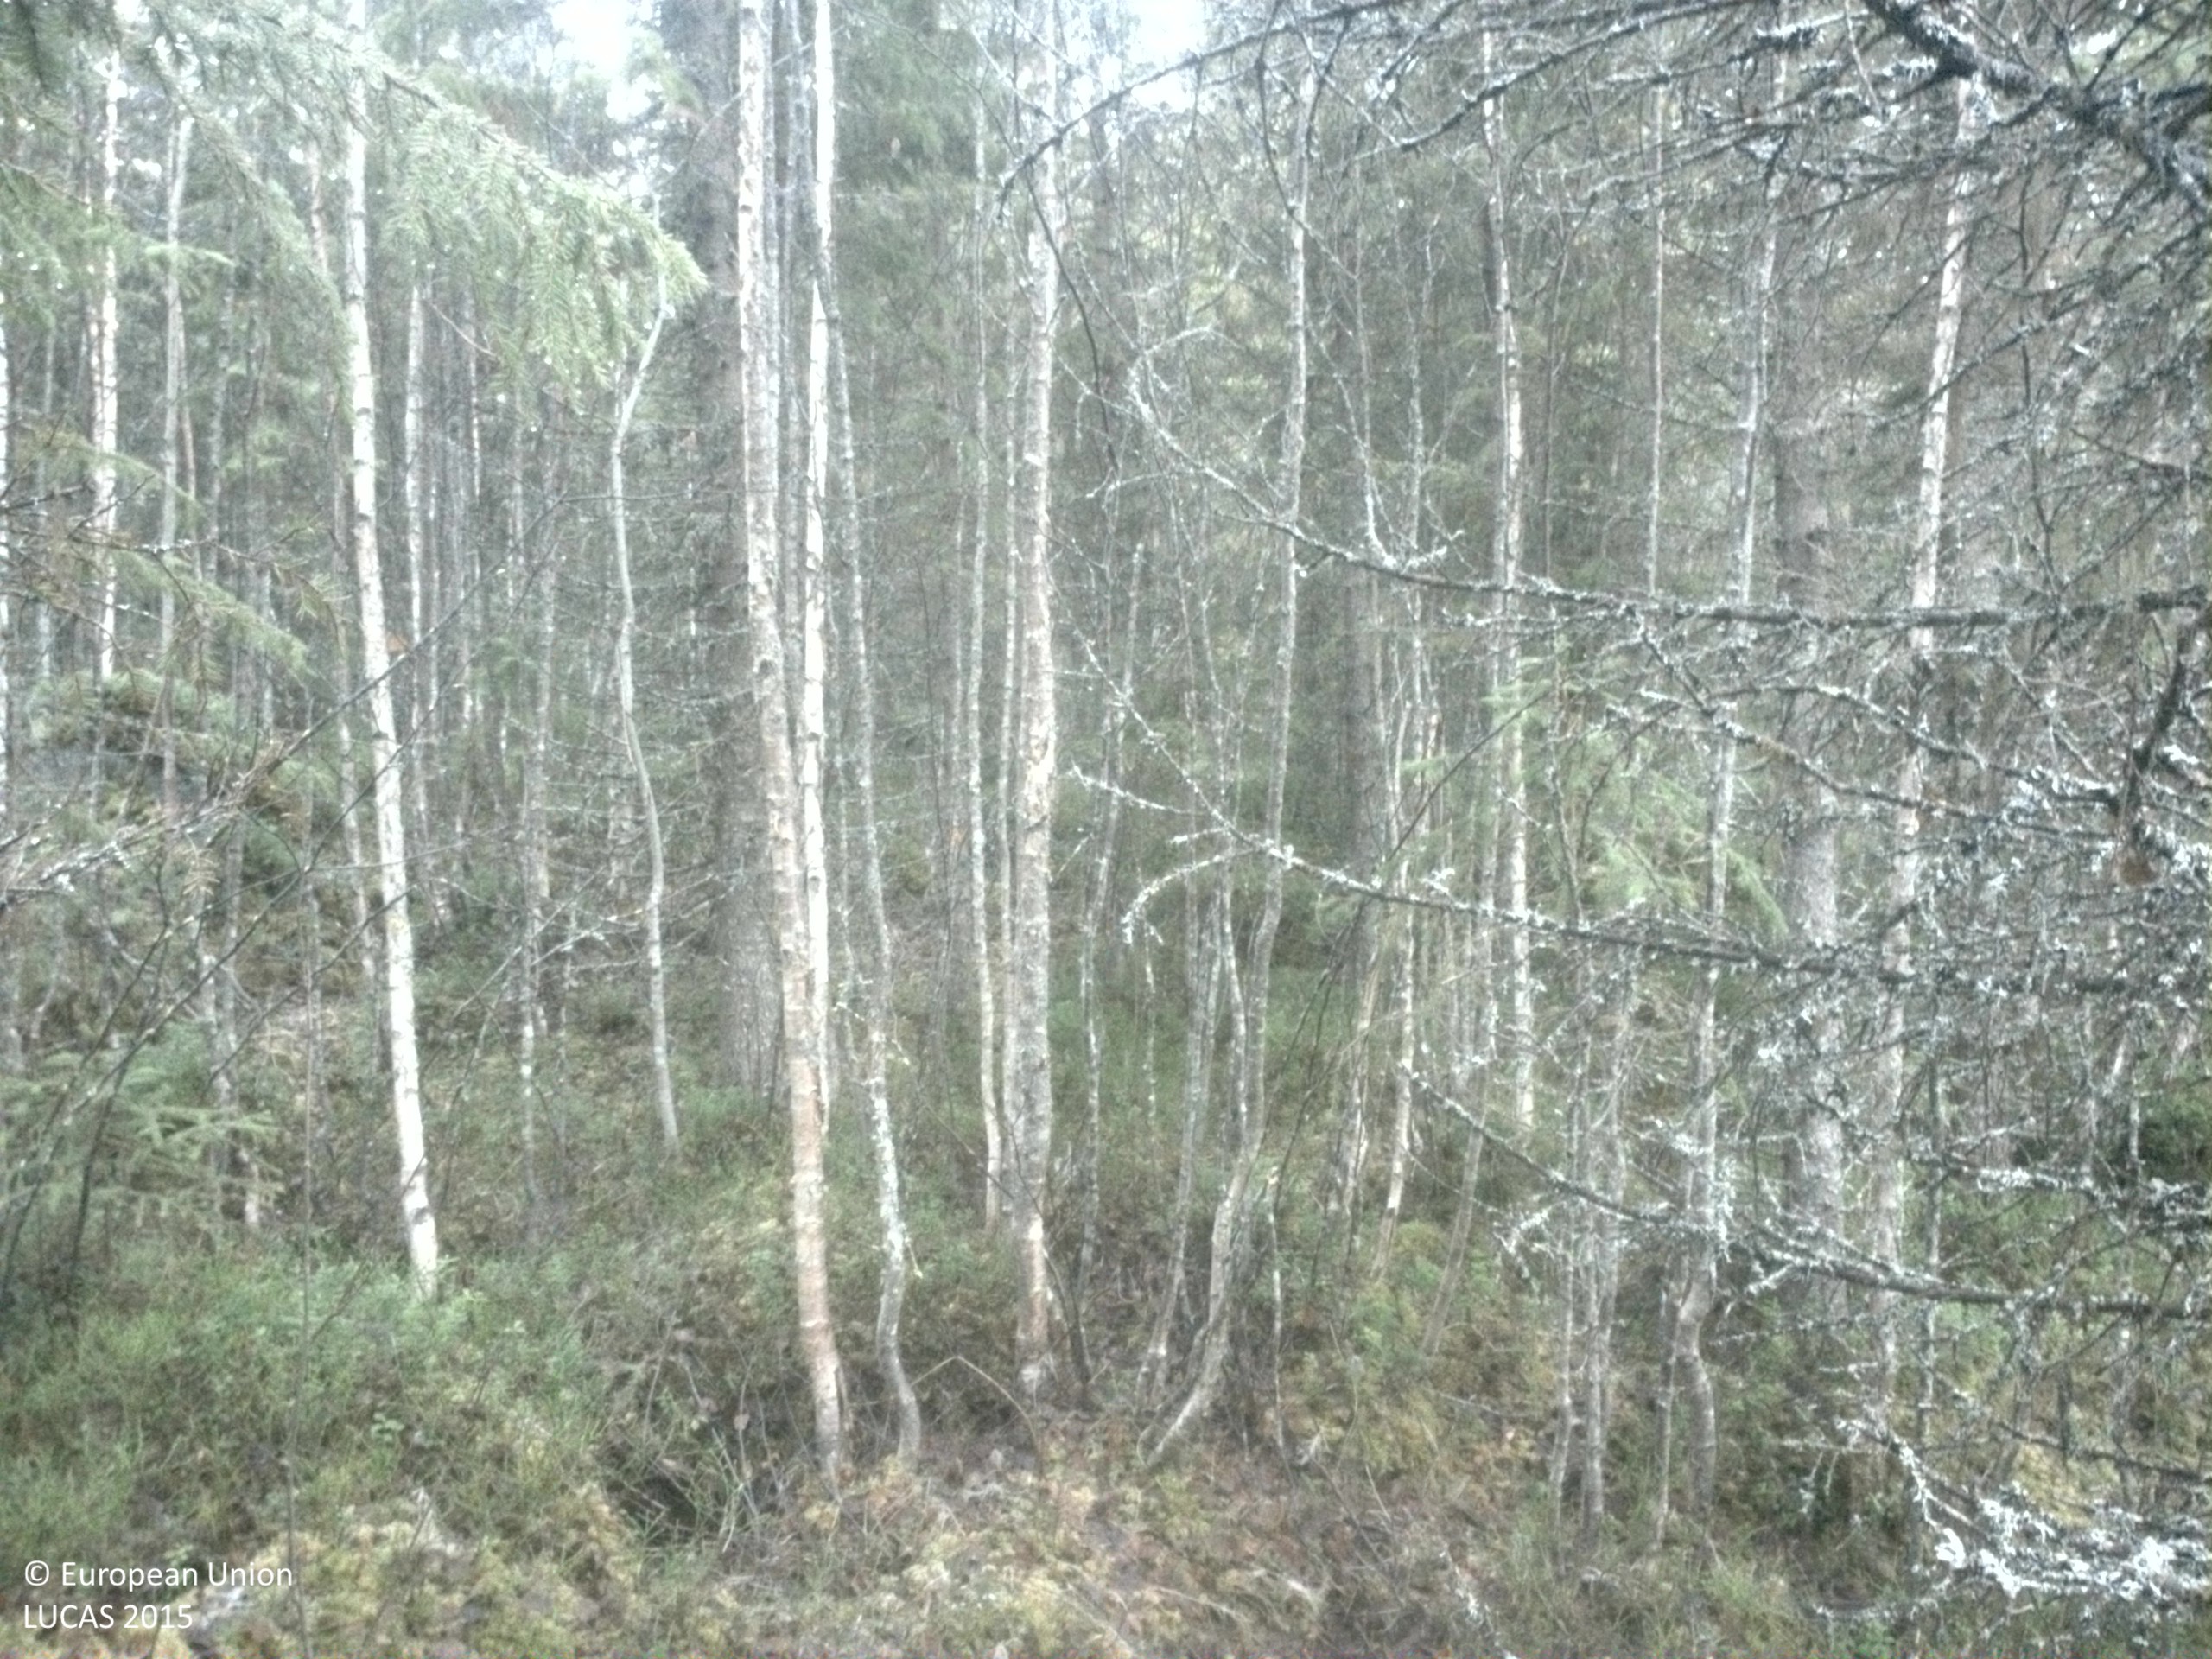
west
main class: Woodland
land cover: Spruce dominated mixed woodland
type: boreal forest
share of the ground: > 75 %
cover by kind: coniferous forest trees 55 %, broadleaved forest trees 20 %, shrubs 15 %, lichens and mosses 10 %
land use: Forestry
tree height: > 5 m
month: November
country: SE
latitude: 63.9081
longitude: 15.9025
